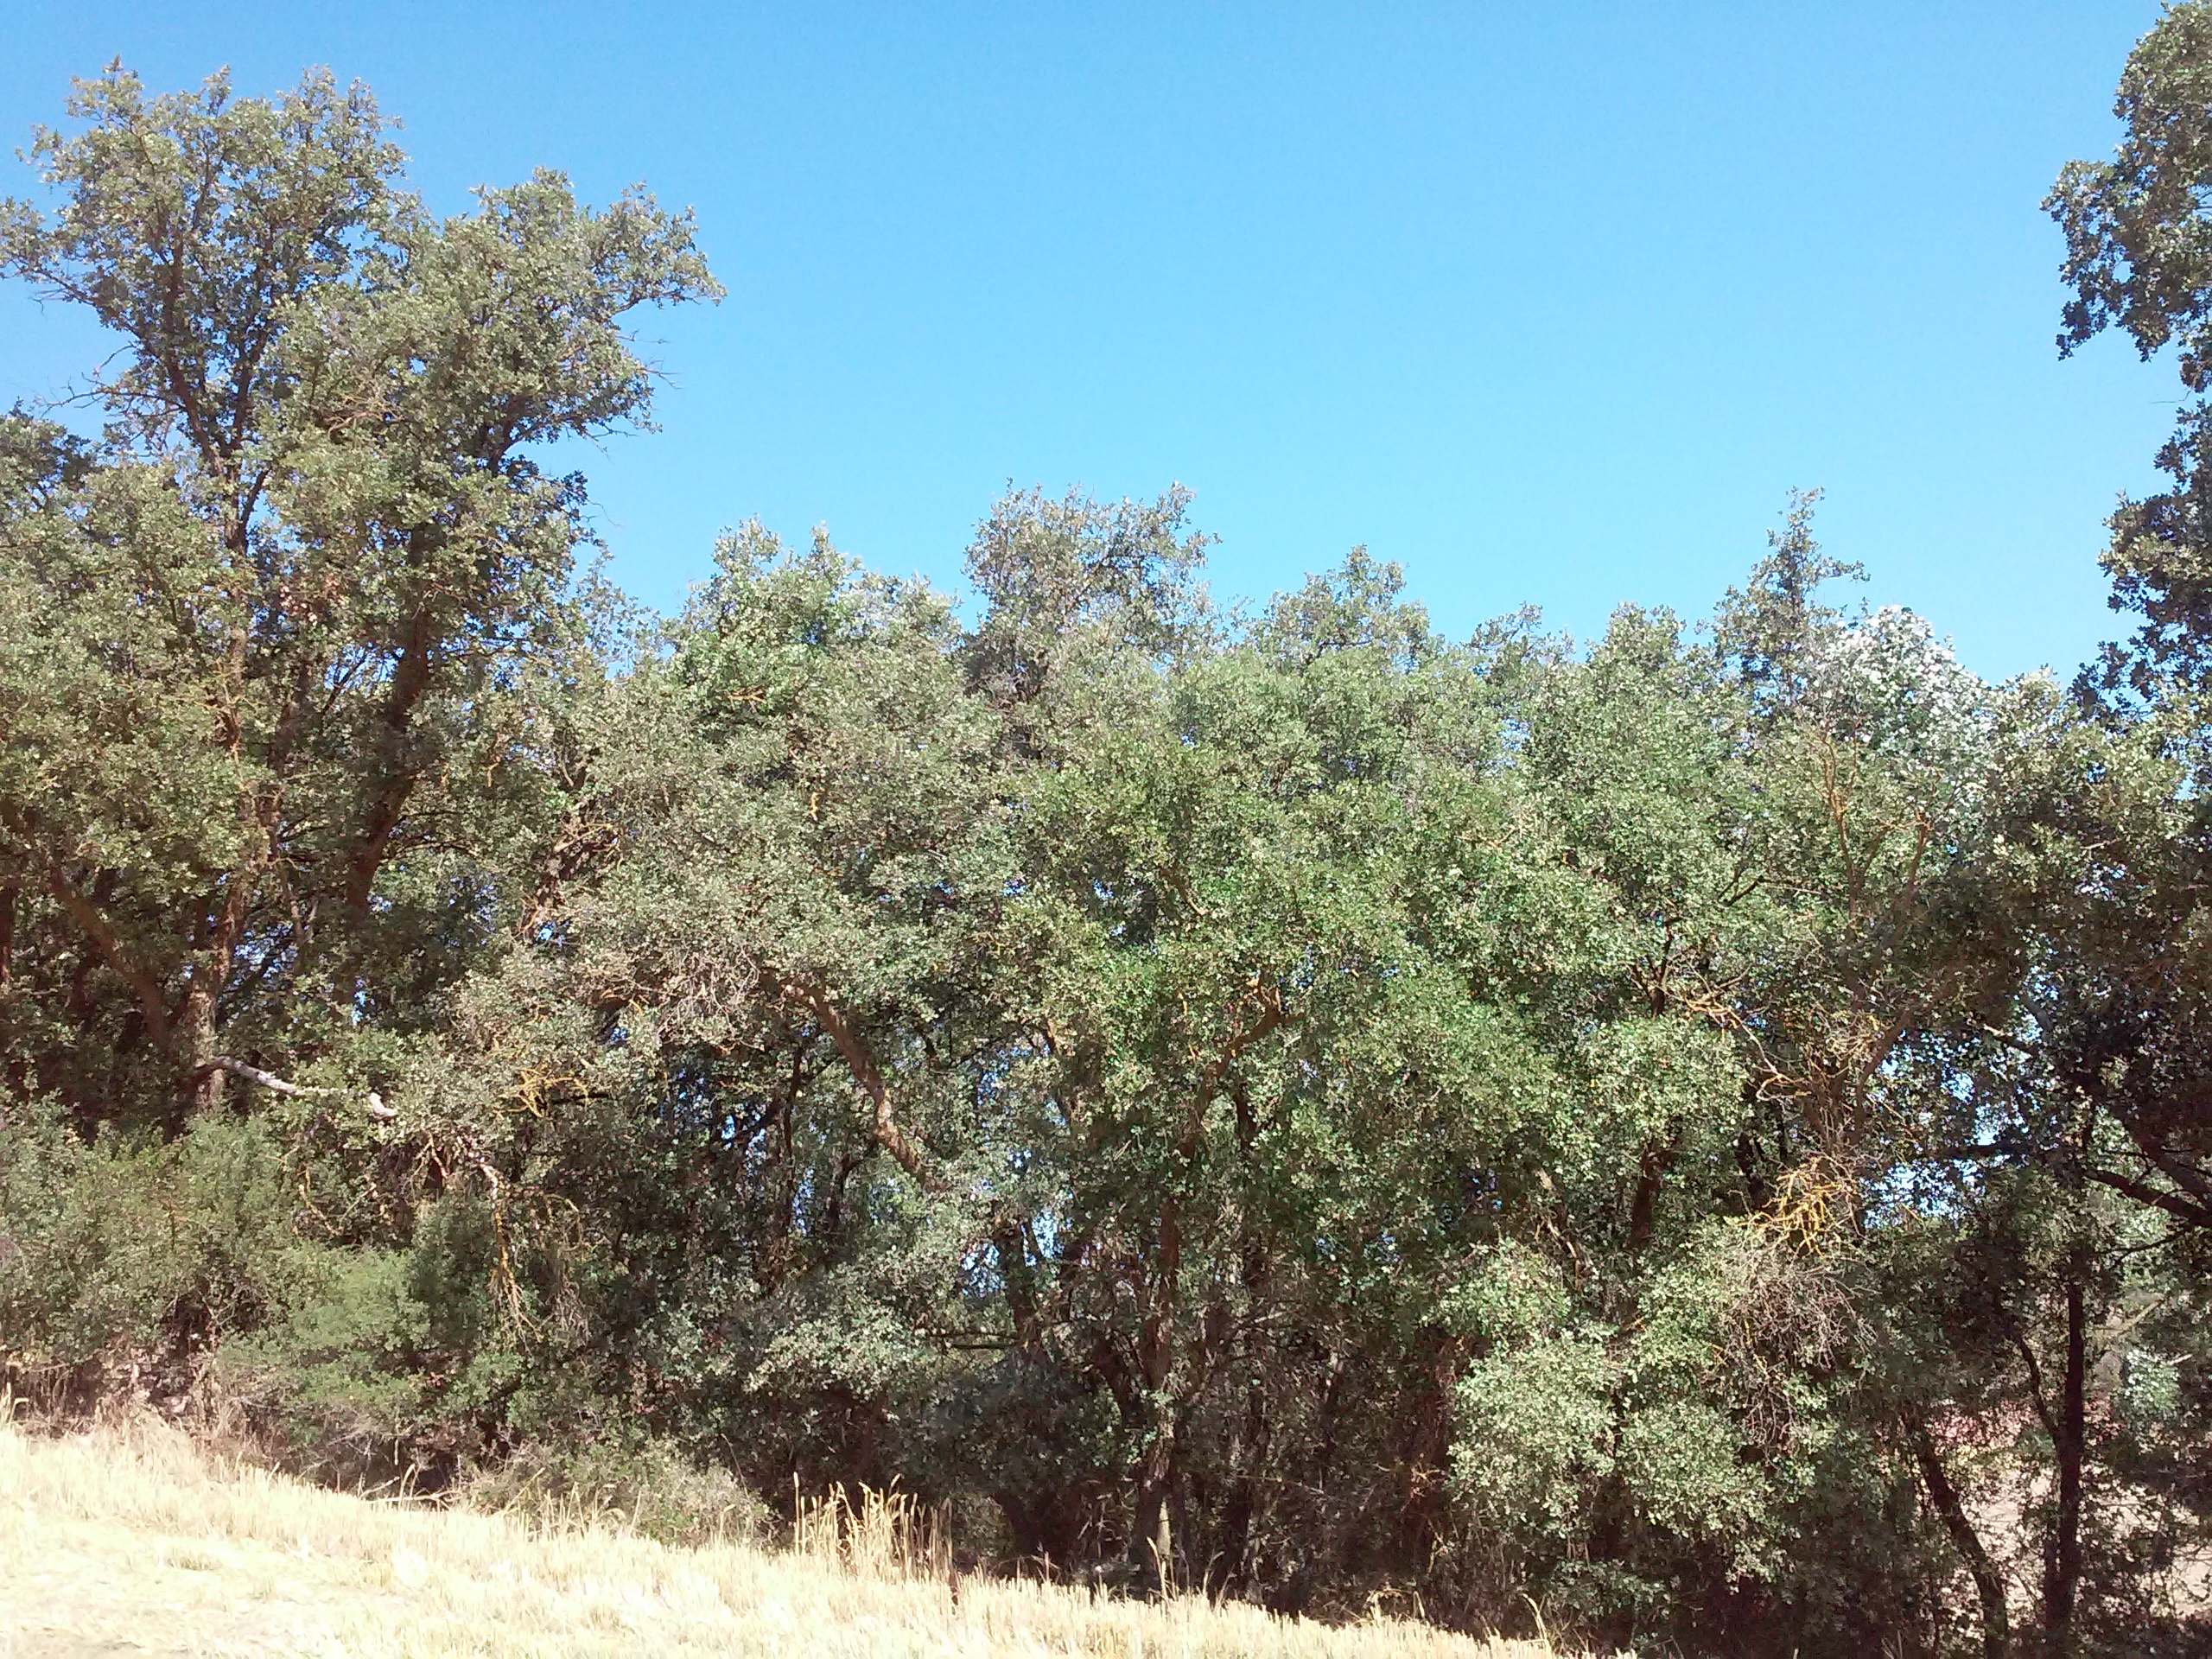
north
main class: Cropland
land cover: Barley
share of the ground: < 10 %
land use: Agriculture (excluding fallow land and kitchen gardens)
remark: Harvested field
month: July
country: ES
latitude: 41.5822
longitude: 1.2223
